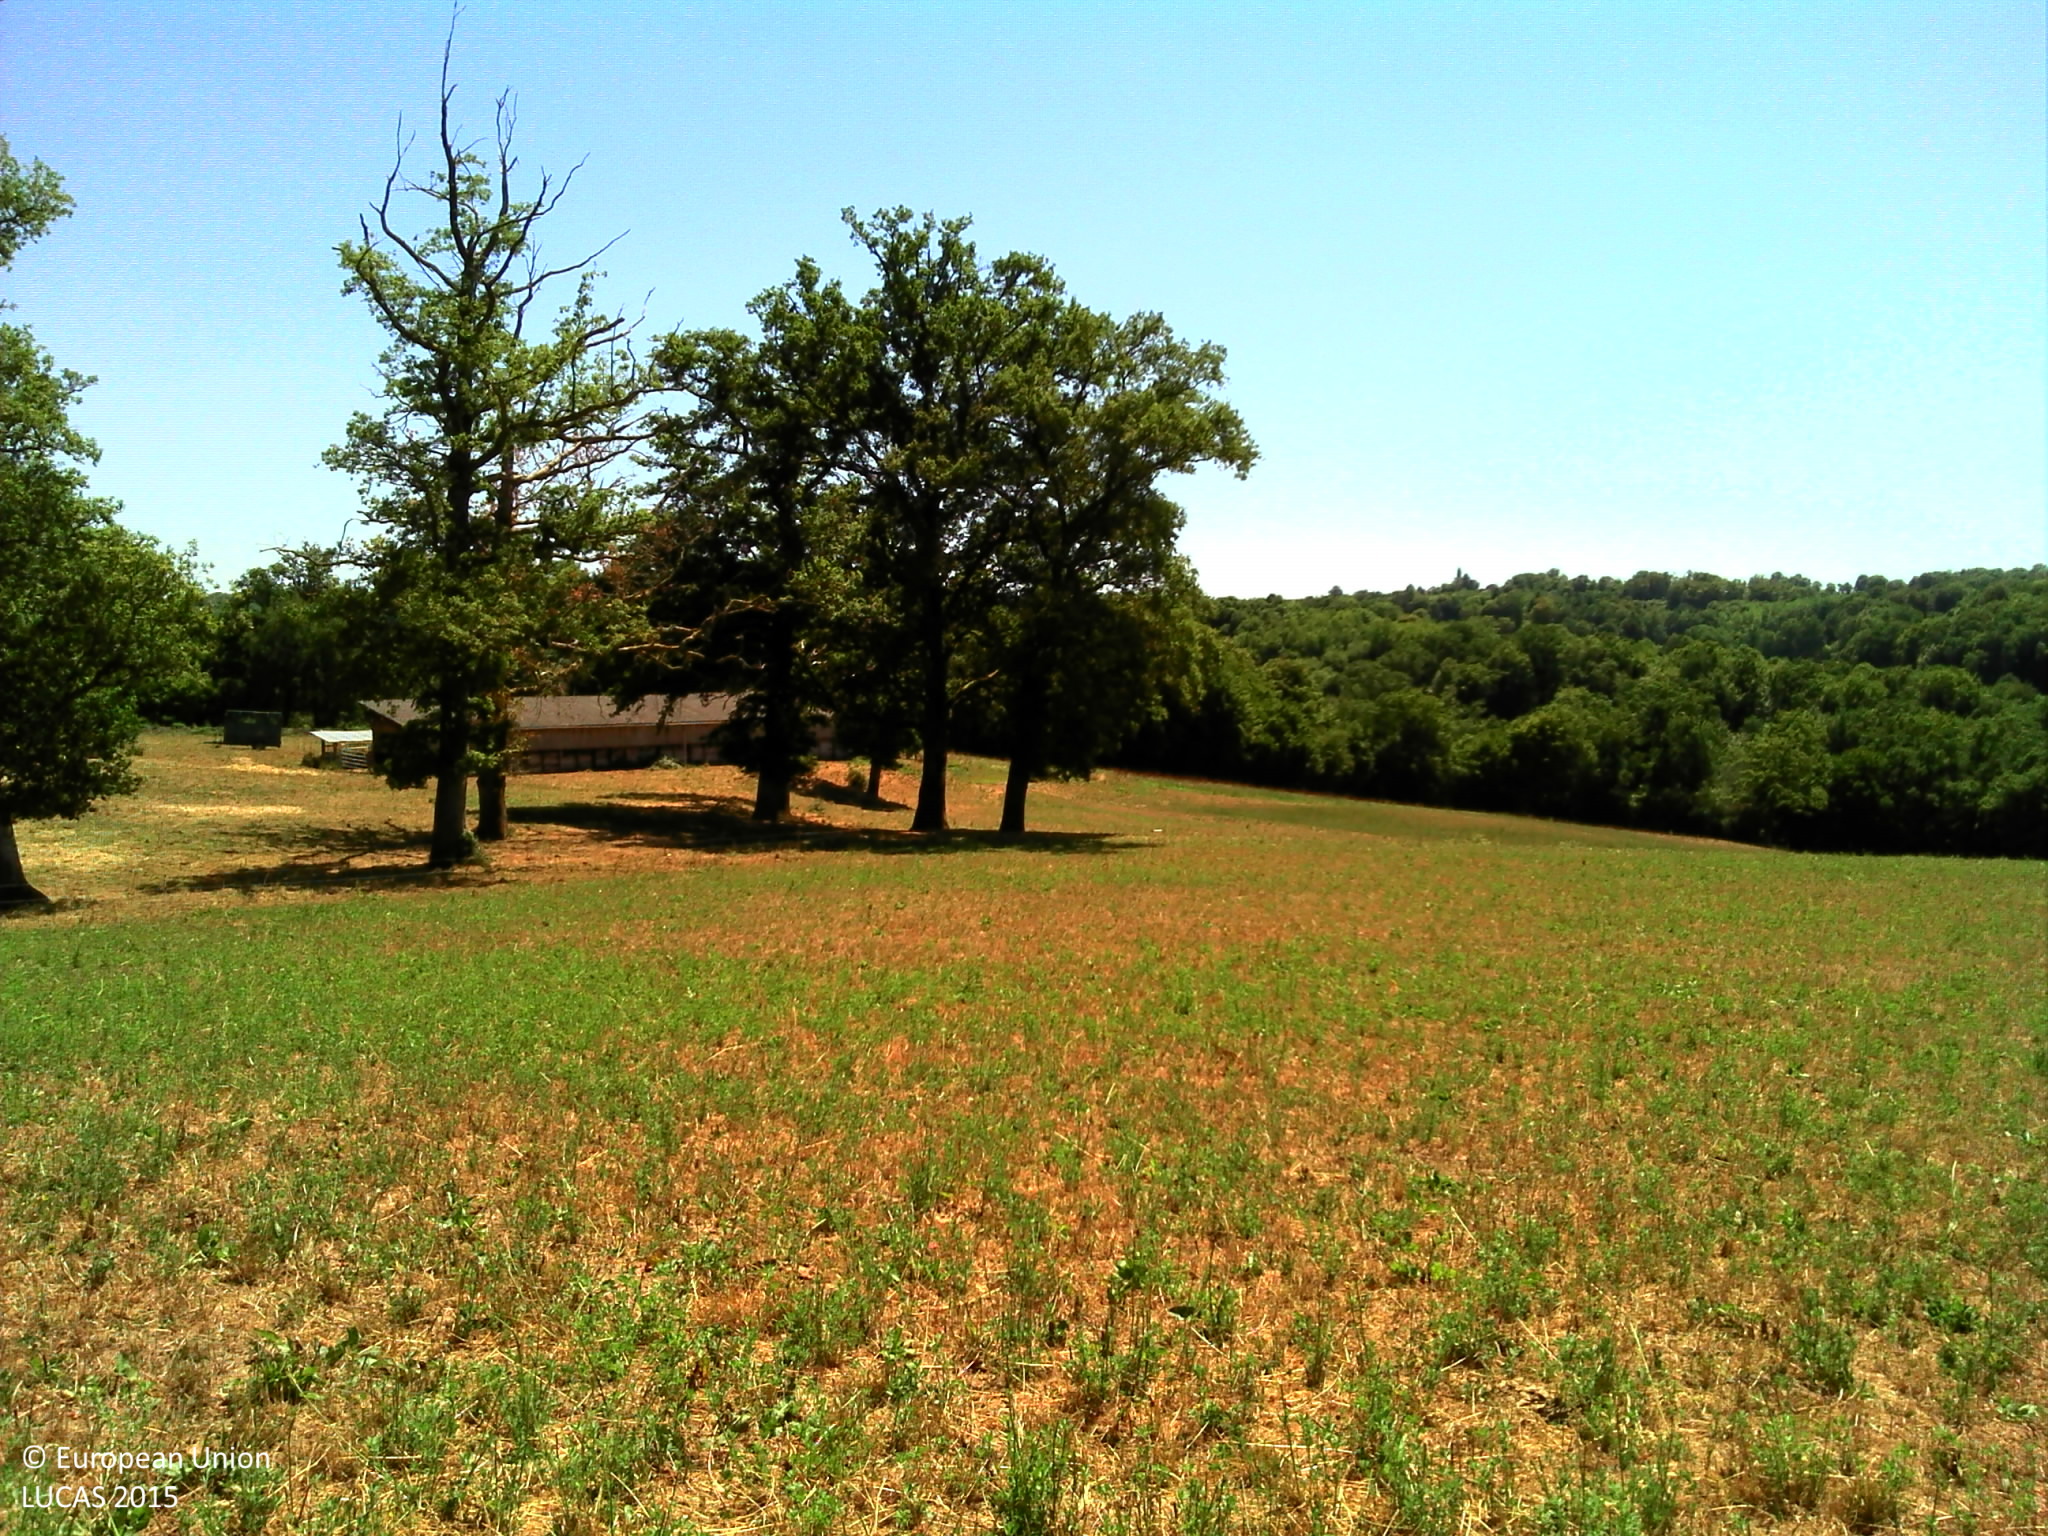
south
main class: Grassland
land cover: Grassland without tree/shrub cover
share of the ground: > 75 %
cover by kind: herbaceous plants 95 %
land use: Agriculture (excluding fallow land and kitchen gardens)
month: July
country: FR
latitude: 45.7185
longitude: 1.4489
